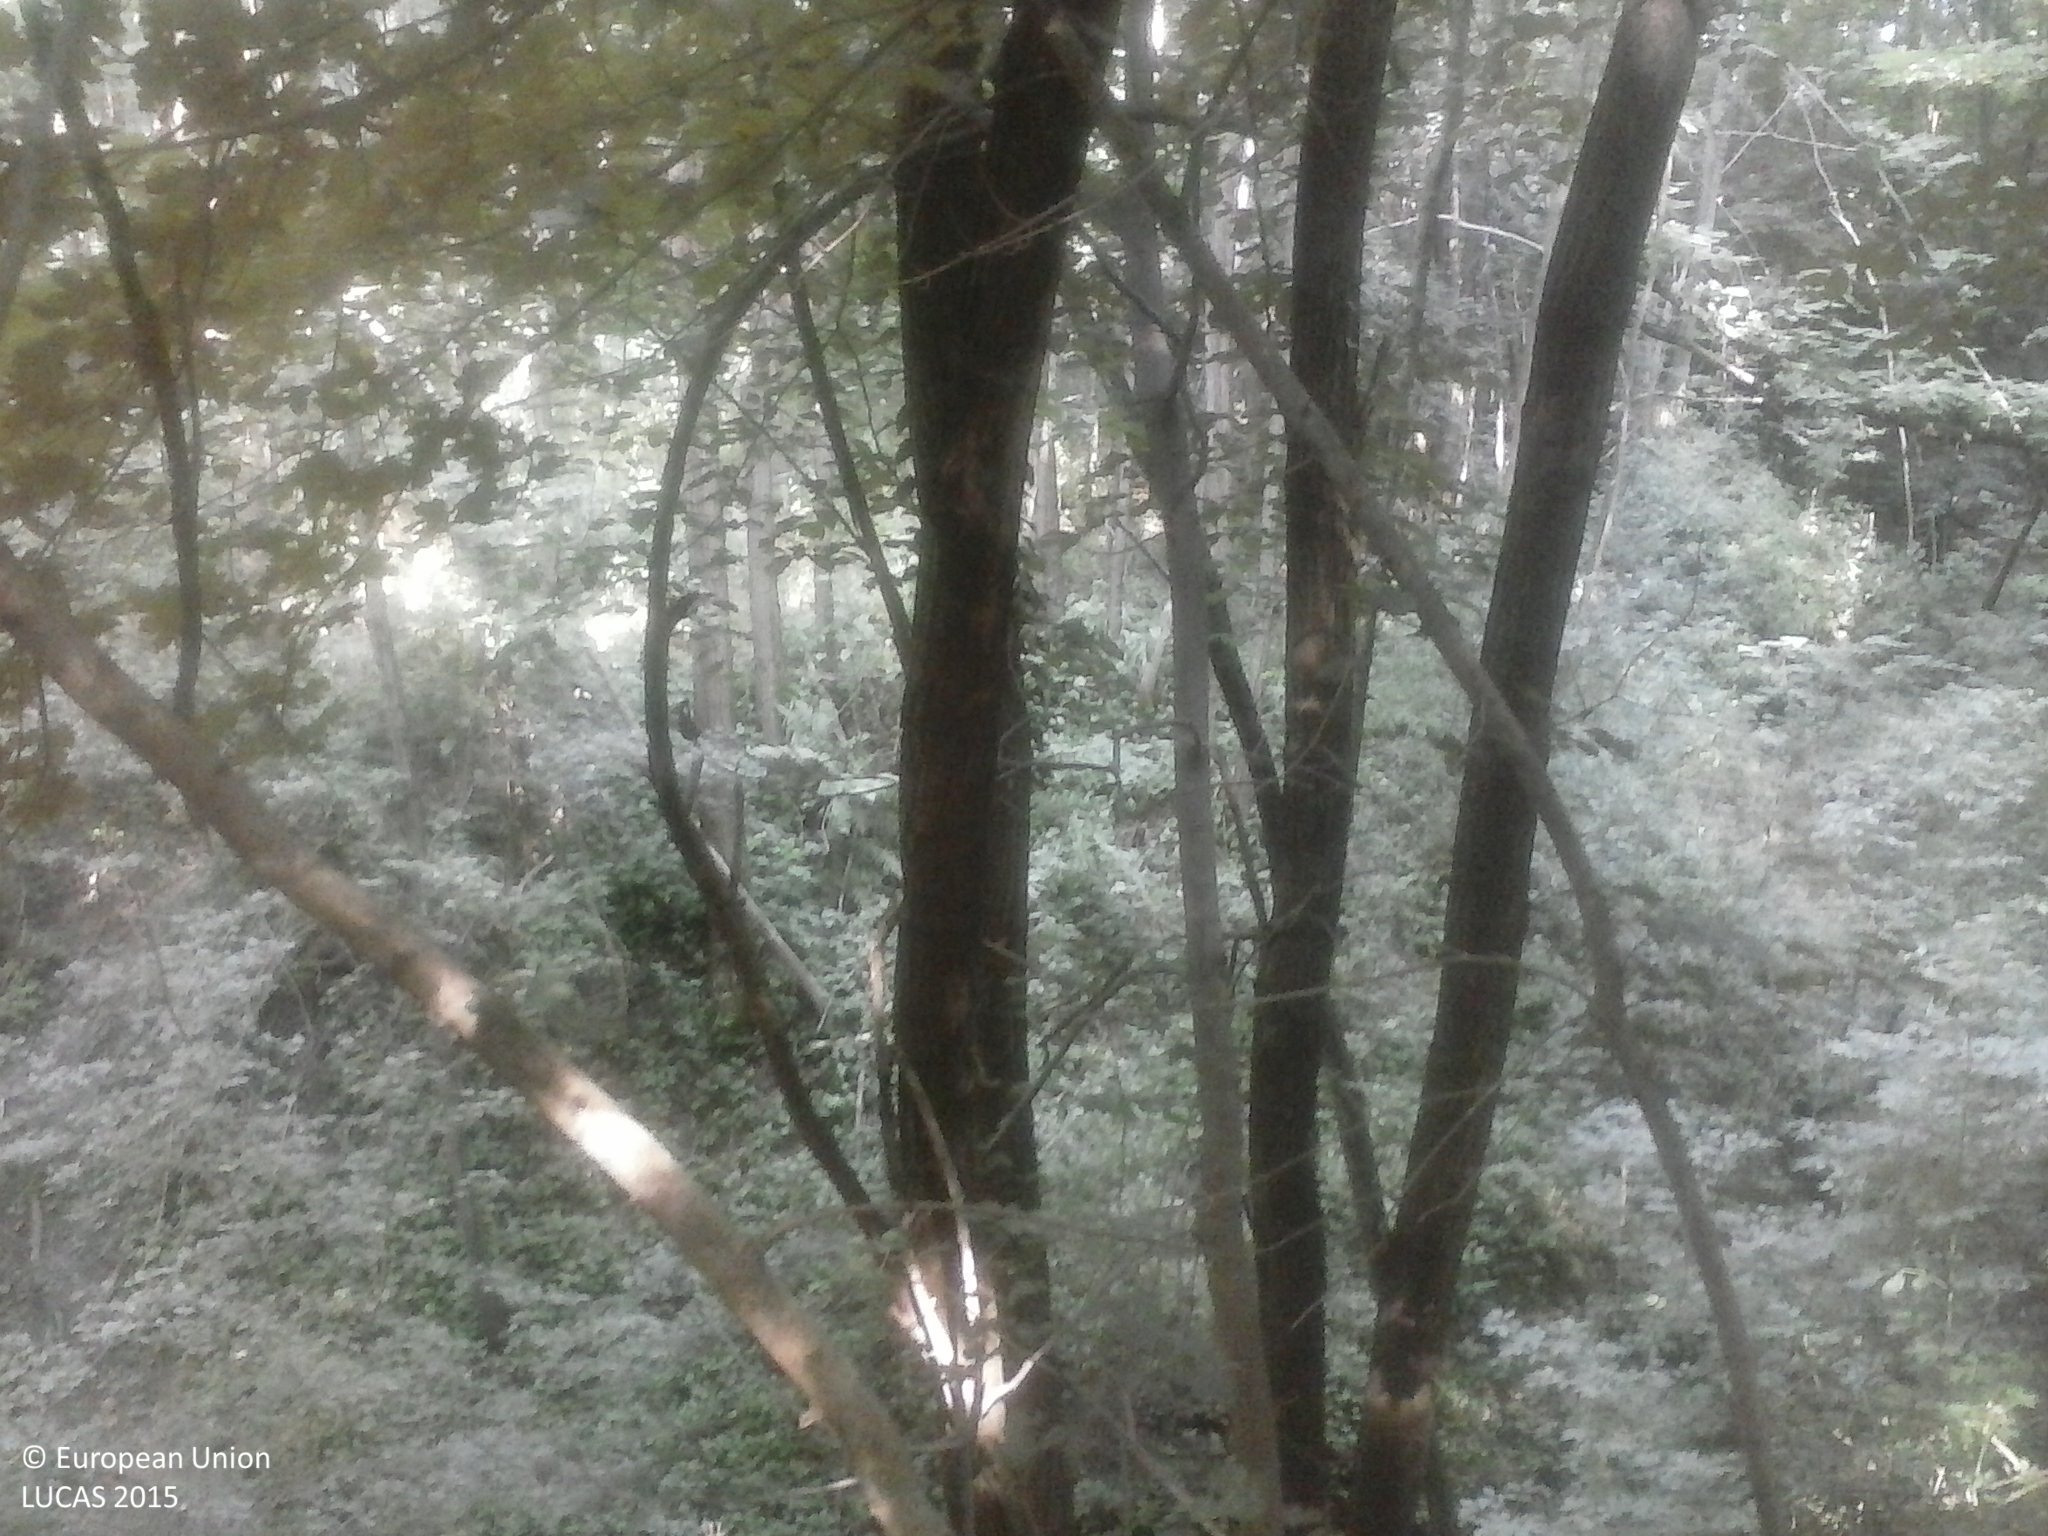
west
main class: Woodland
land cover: Broadleaved woodland
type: mesophytic deciduous forest
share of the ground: > 75 %
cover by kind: broadleaved forest trees 90 %, shrubs 5 %, herbaceous plants 5 %
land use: Semi-natural and natural areas not in use
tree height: > 5 m
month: August
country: HU
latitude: 46.2093
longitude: 17.8212
